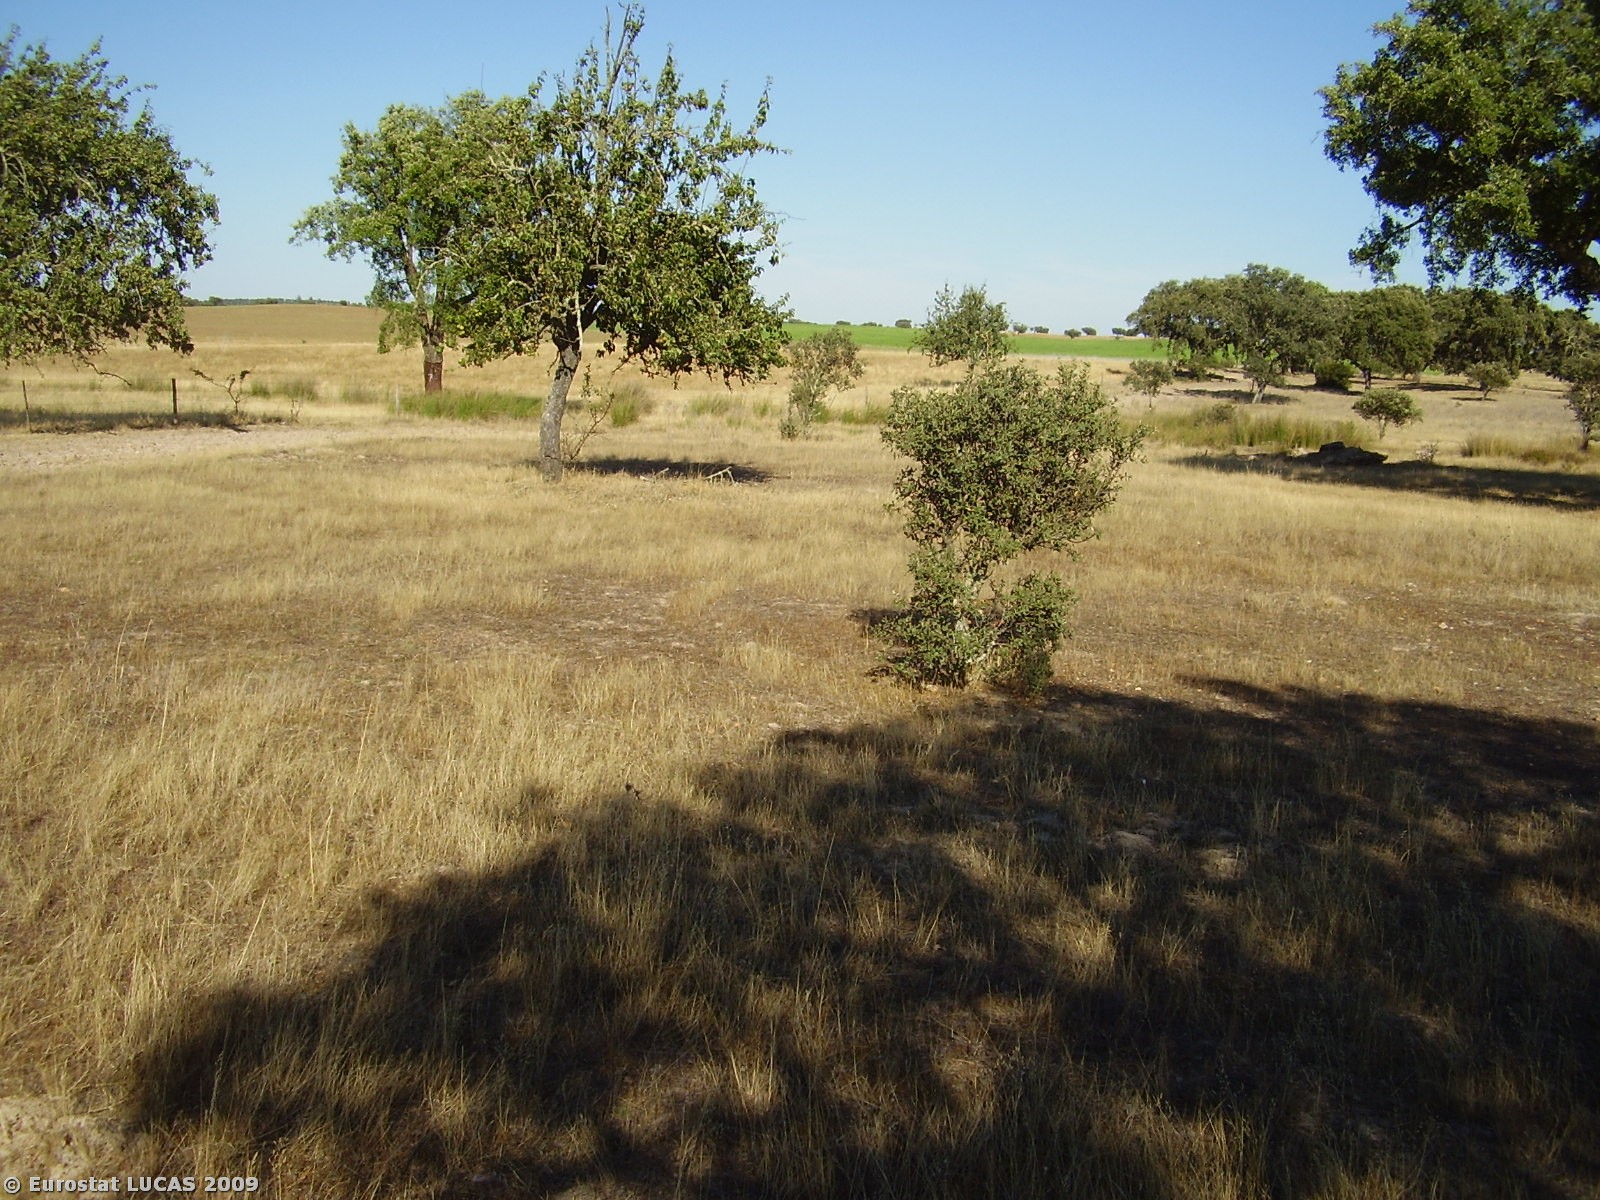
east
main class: Grassland
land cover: Grassland with sparse tree/shrub cover
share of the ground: > 75 %
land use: Fallow land
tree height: > 5 m
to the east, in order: Grassland with sparse tree/shrub cover; Fences; Tracks; Single bushes/trees; Rivers and streams; Grassland without tree/shrub cover
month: July
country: PT
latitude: 38.9052
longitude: -7.9788
